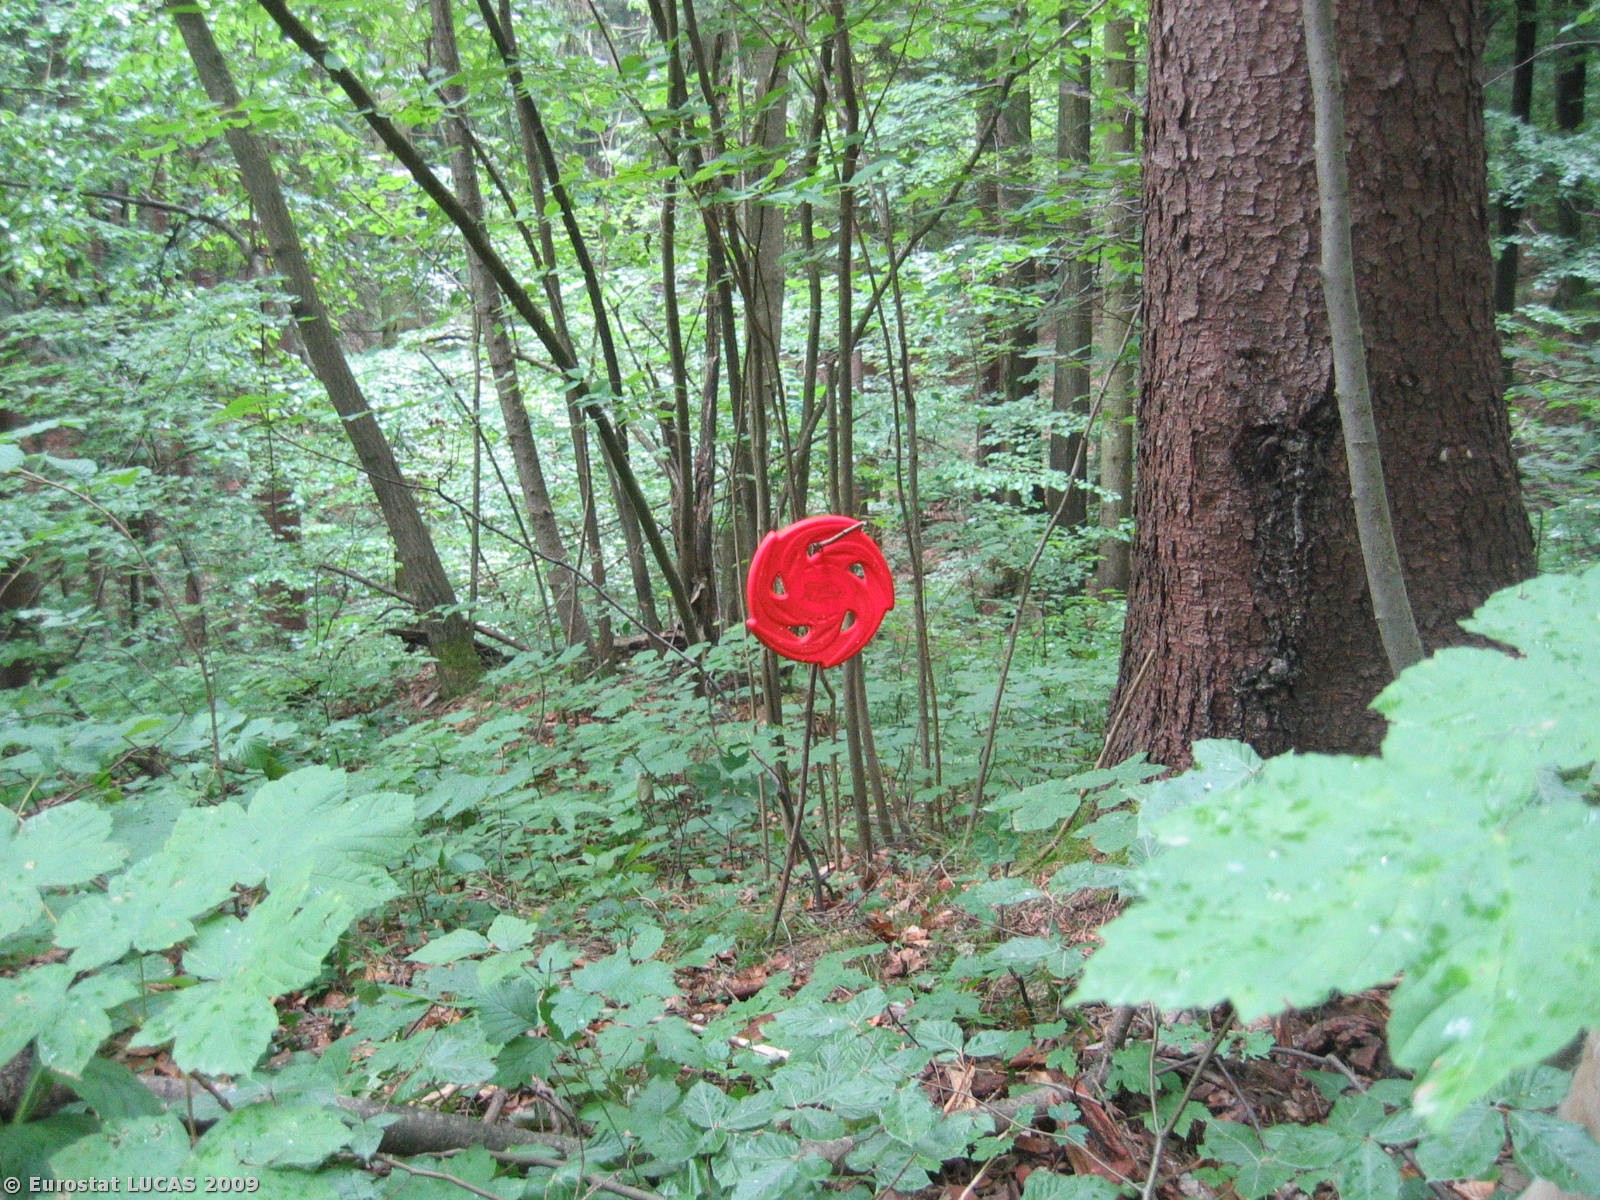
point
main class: Woodland
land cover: Mixed woodland
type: beech forest
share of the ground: > 75 %
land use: Forestry
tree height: > 5 m
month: July
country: SI
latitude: 45.9975
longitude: 14.2184
